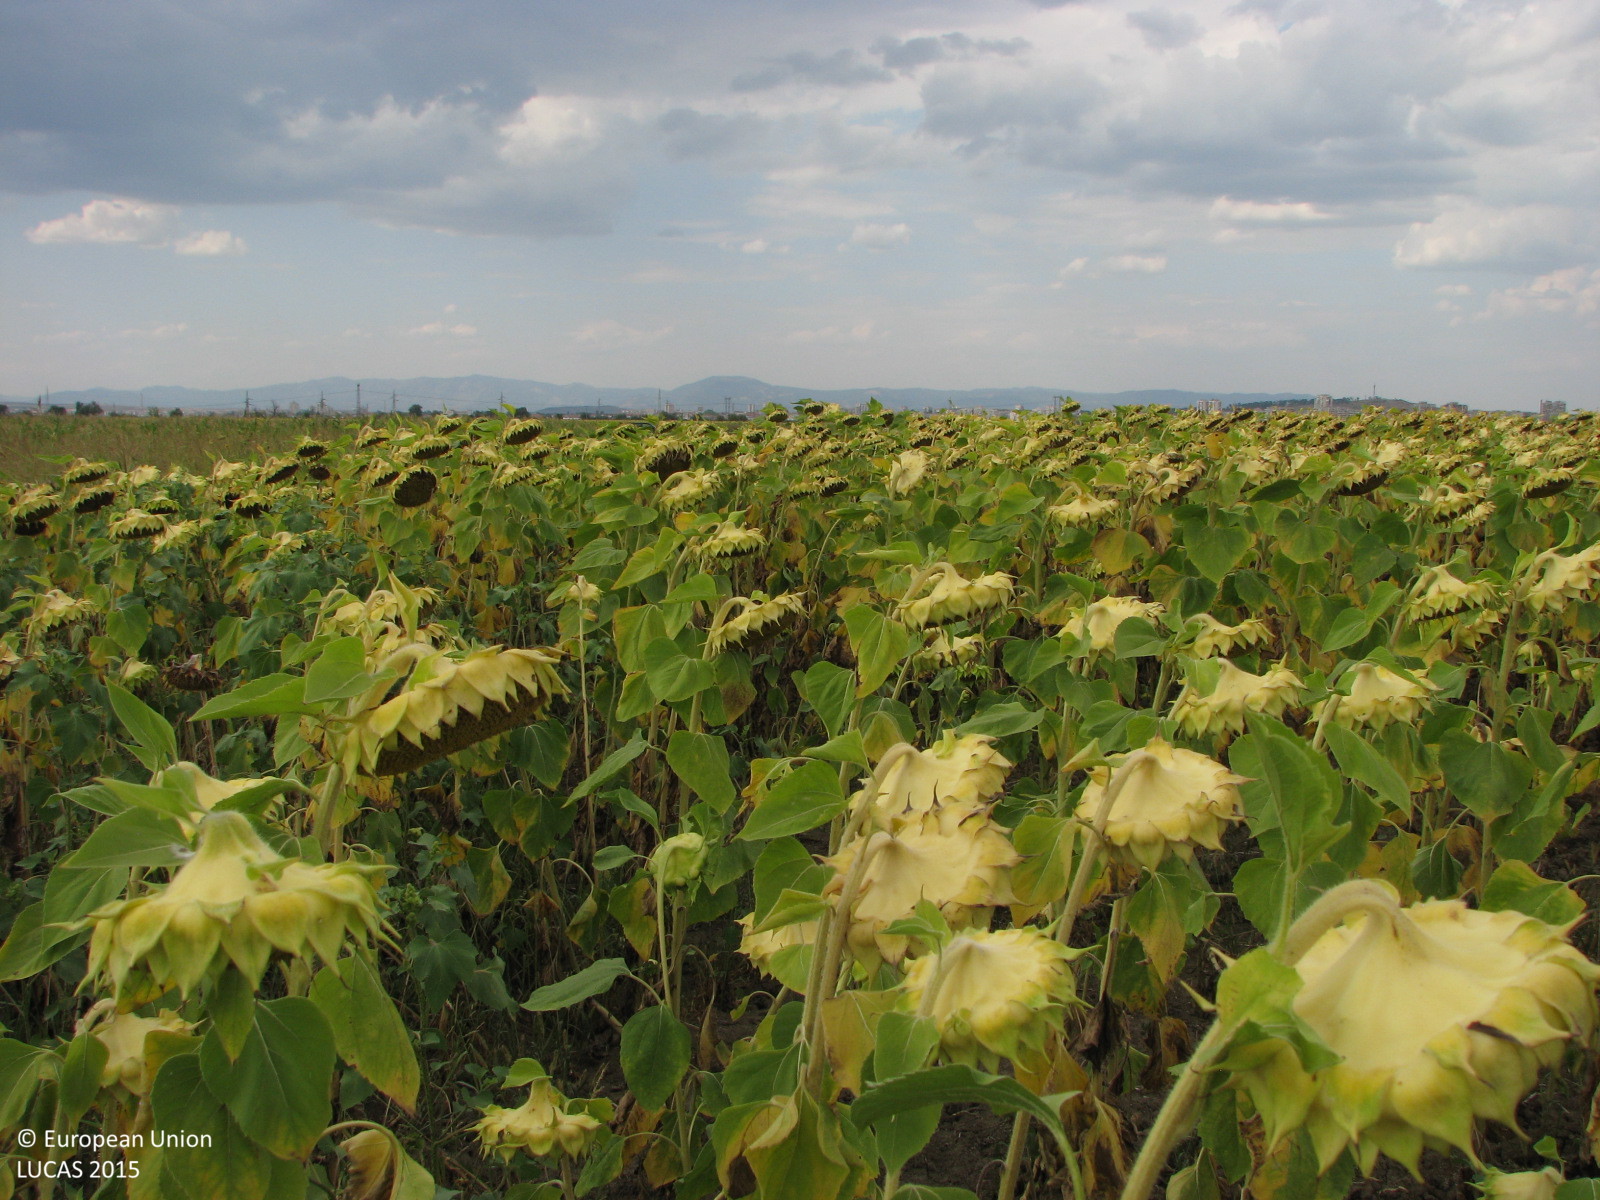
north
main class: Cropland
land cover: Sunflower
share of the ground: > 75 %
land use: Agriculture (excluding fallow land and kitchen gardens)
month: August
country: BG
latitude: 42.4457
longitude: 26.5175
